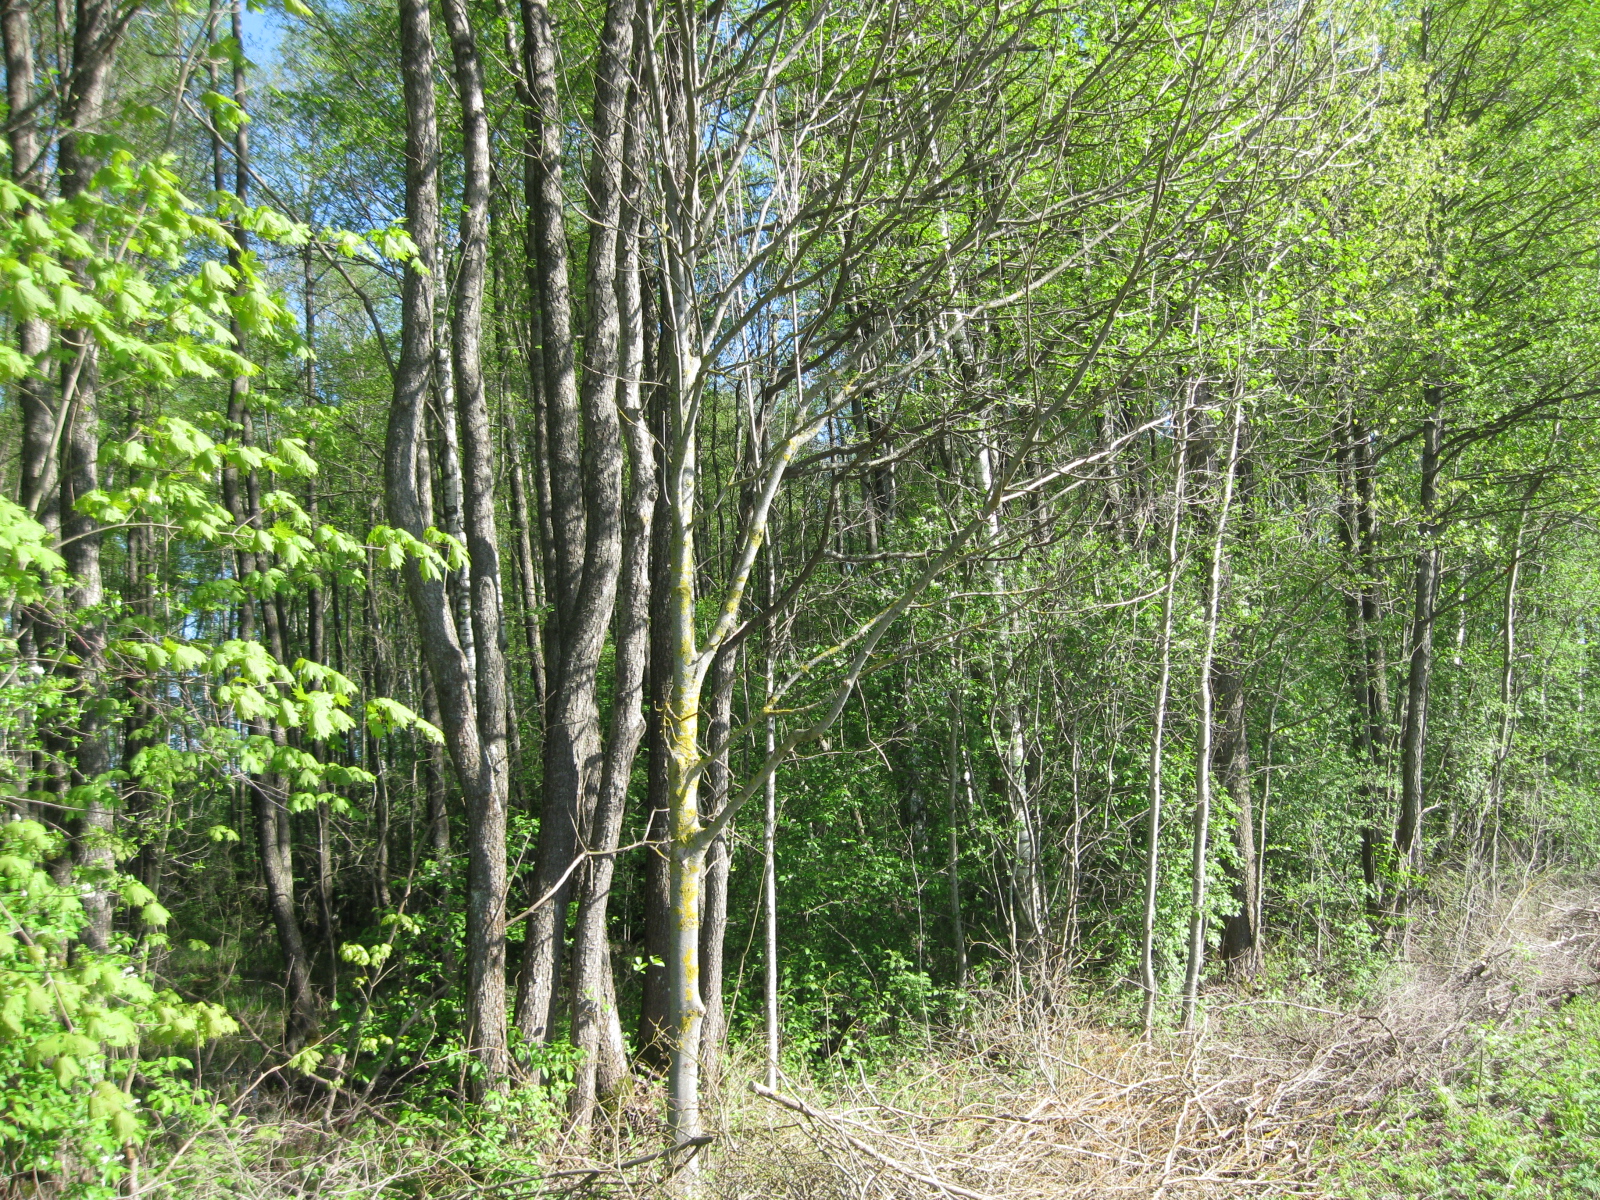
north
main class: Grassland
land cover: Spontaneously vegetated surfaces
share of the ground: 50 - 75 %
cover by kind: herbaceous plants 60 %, unconsolidated bare surface 40 %
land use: Agriculture (excluding fallow land and kitchen gardens)
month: May
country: LT
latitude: 56.0234
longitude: 24.9168
